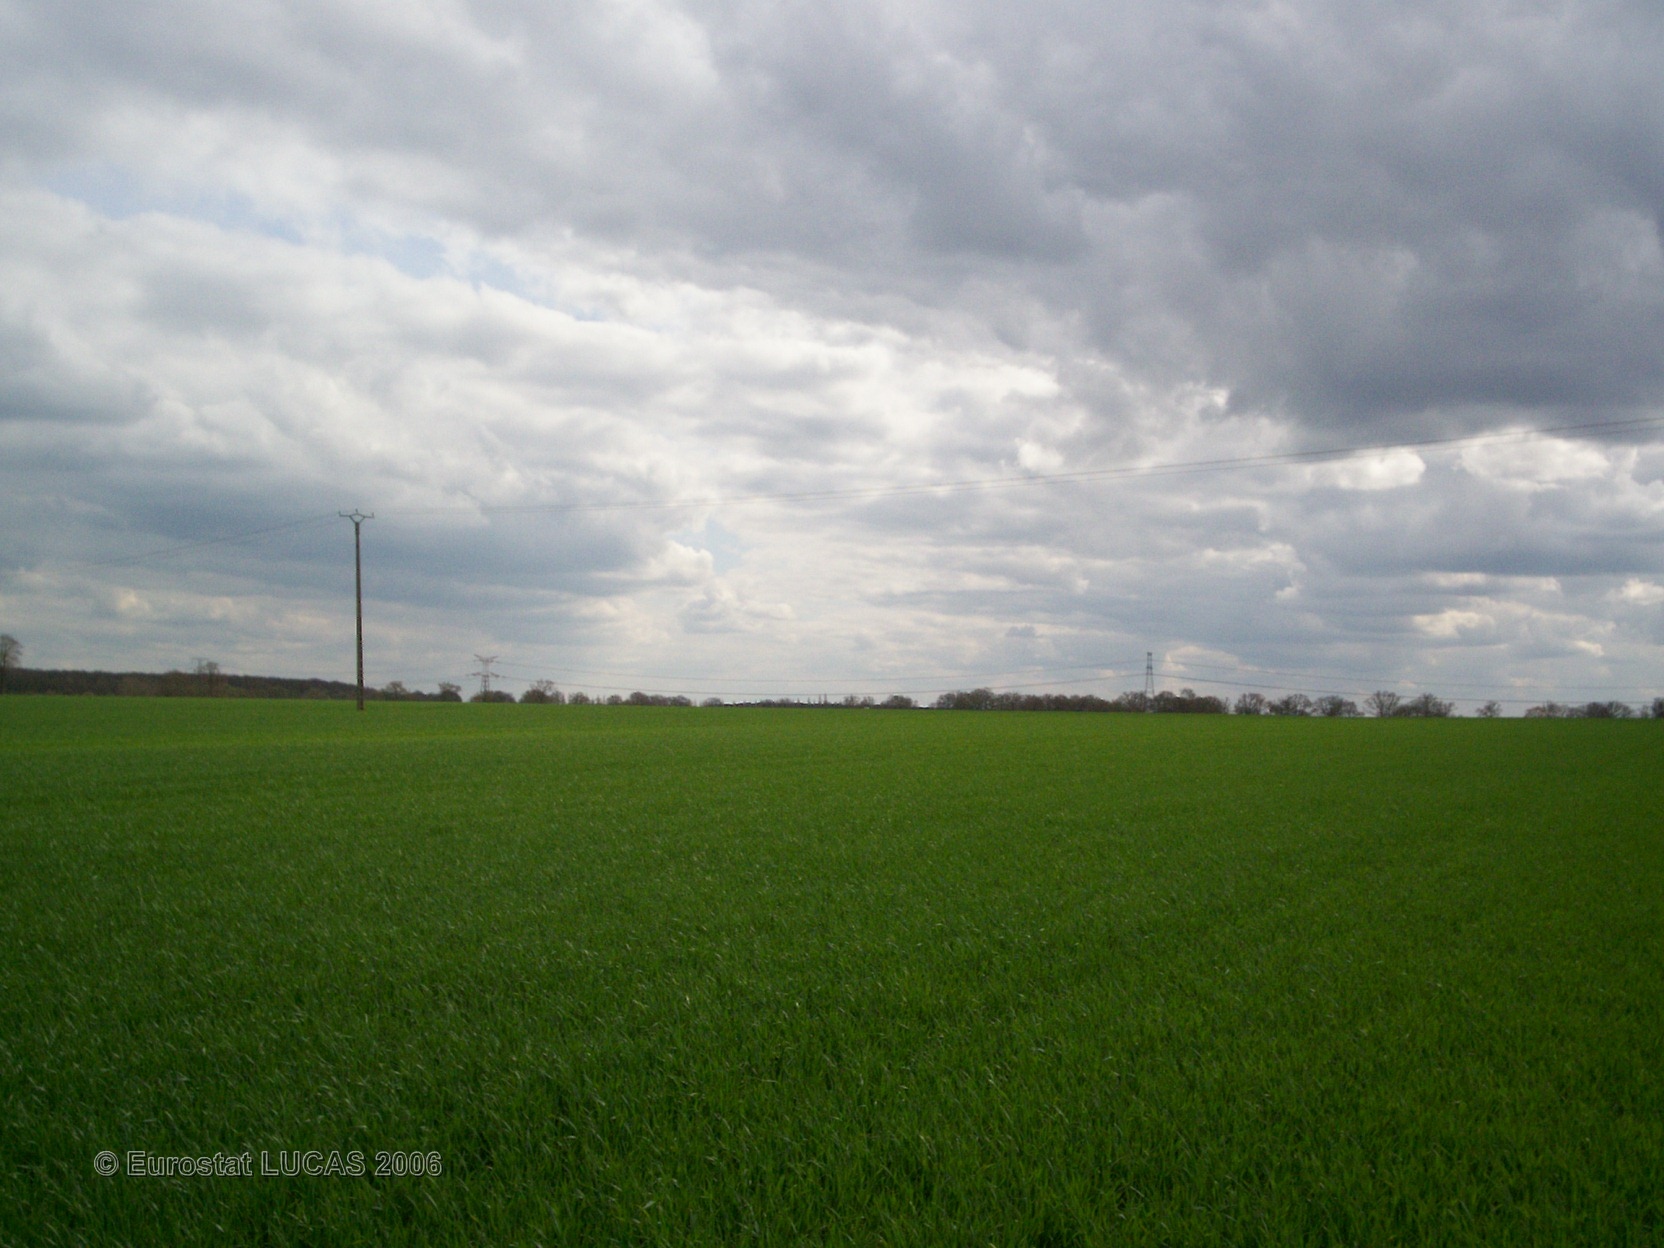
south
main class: Cropland
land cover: Common wheat
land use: Agriculture (excluding fallow land and kitchen gardens)
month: April
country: FR
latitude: 47.9293
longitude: -0.5941
